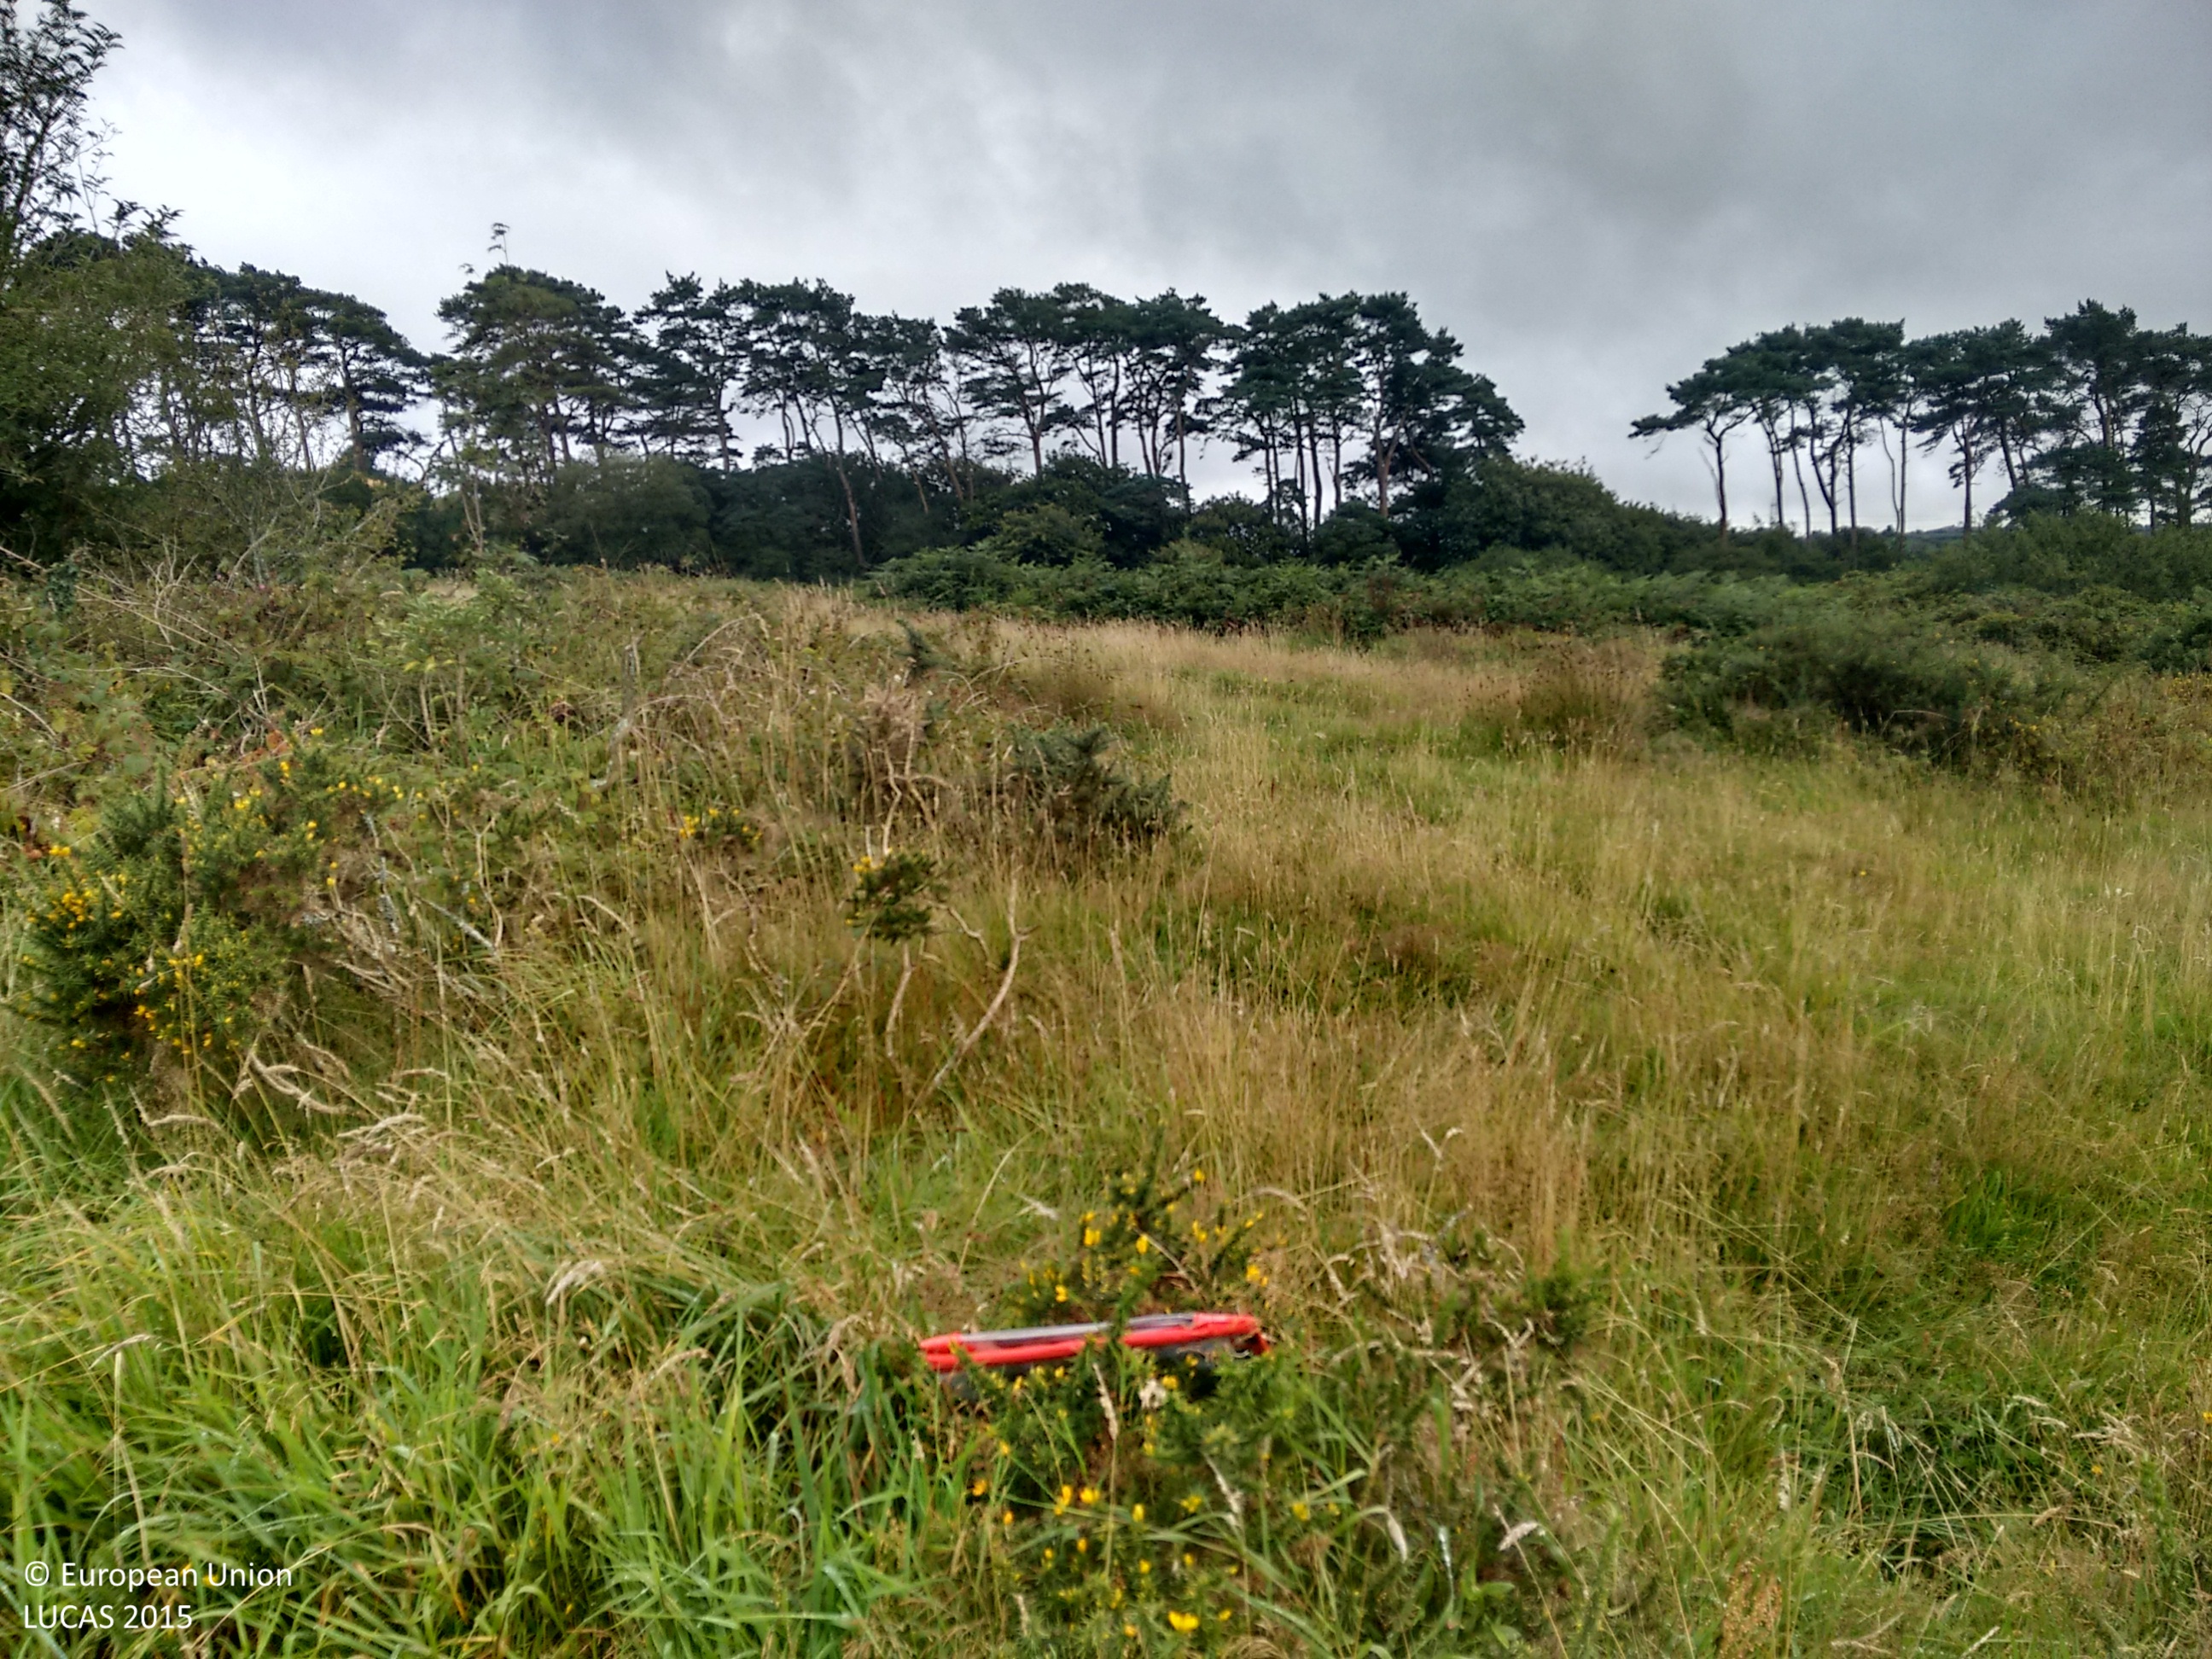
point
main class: Shrubland
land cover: Shrubland with sparse tree cover
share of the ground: > 75 %
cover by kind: herbaceous plants 65 %, shrubs 30 %, broadleaved forest trees 5 %
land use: Agriculture (excluding fallow land and kitchen gardens)
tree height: < 5 m
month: August
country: GB
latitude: 51.7625
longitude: -4.7302
